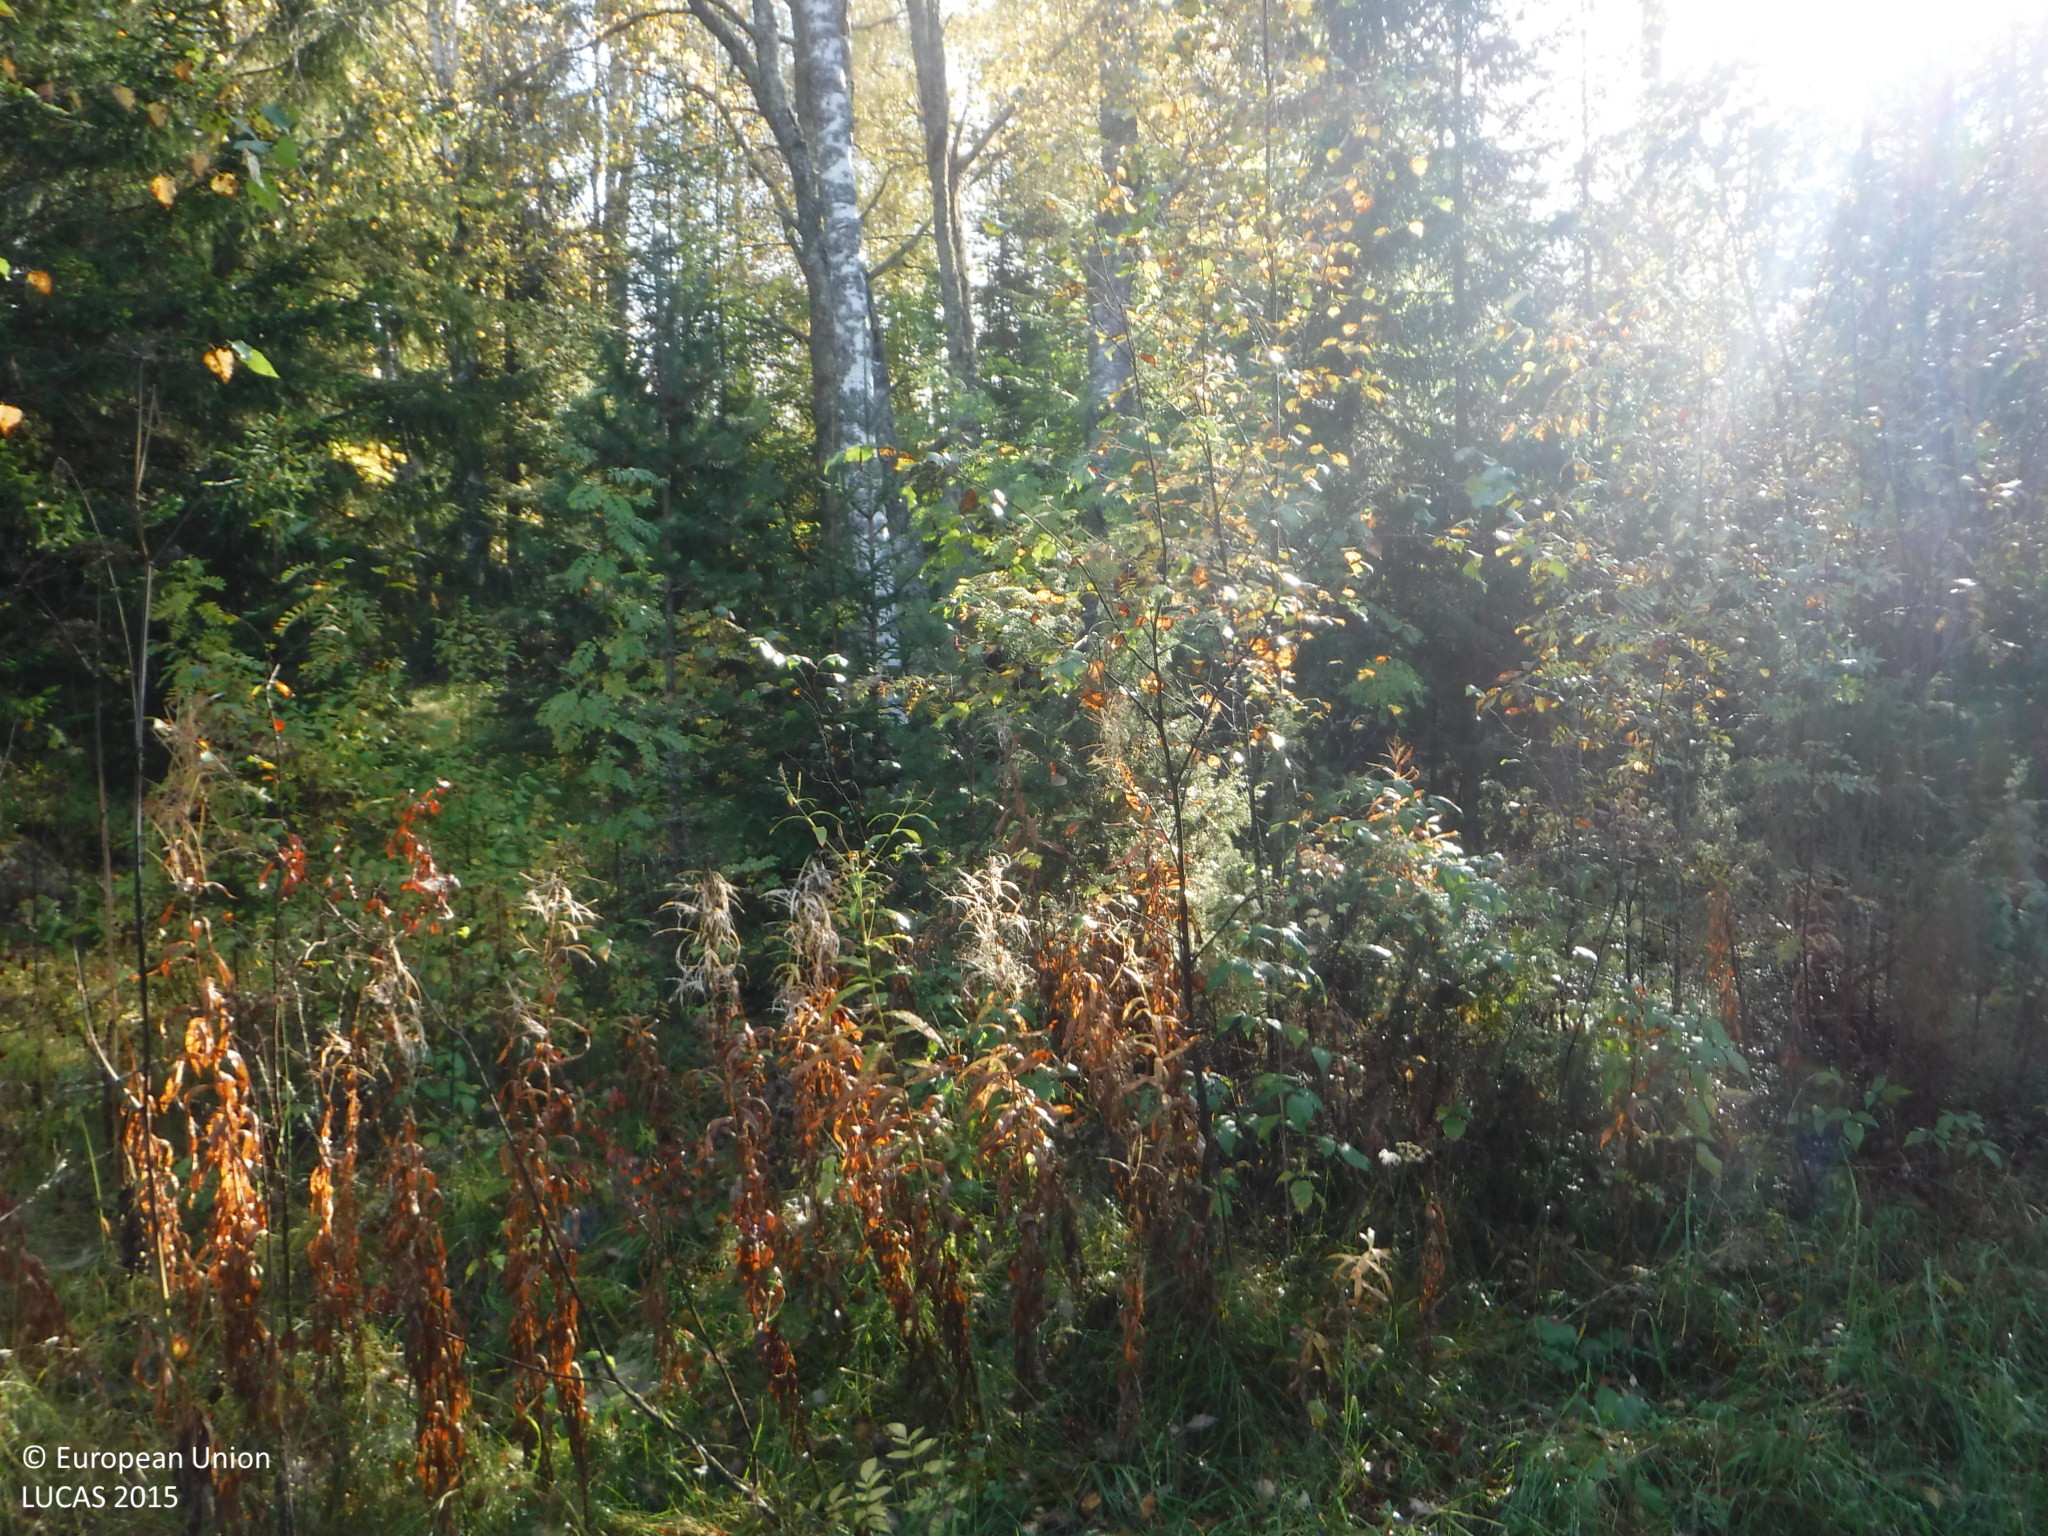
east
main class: Artificial land
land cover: Non built-up linear features
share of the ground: > 75 %
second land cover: Grassland without tree/shrub cover
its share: > 75 %
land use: Road transport
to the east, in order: Ditches and canals; Tracks; Grassland without tree/shrub cover; Shruby margins; Other mixed woodland; Electric lines; Other mixed woodland; Grass margins; Ditches and canals; Grass margins; Paved roads, cycling and walking lanes; Grass margins; Ditches and canals; Grass margins; Paved roads, cycling and walking lanes; Grass margins; Electric lines; Grass margins; Ditches and canals; Grass margins; Oats; Grass margins; Ditches and canals; Shruby margins; Spontaneously vegetated surfaces; Other coniferous woodland
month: September
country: FI
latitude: 62.0870
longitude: 22.5249
